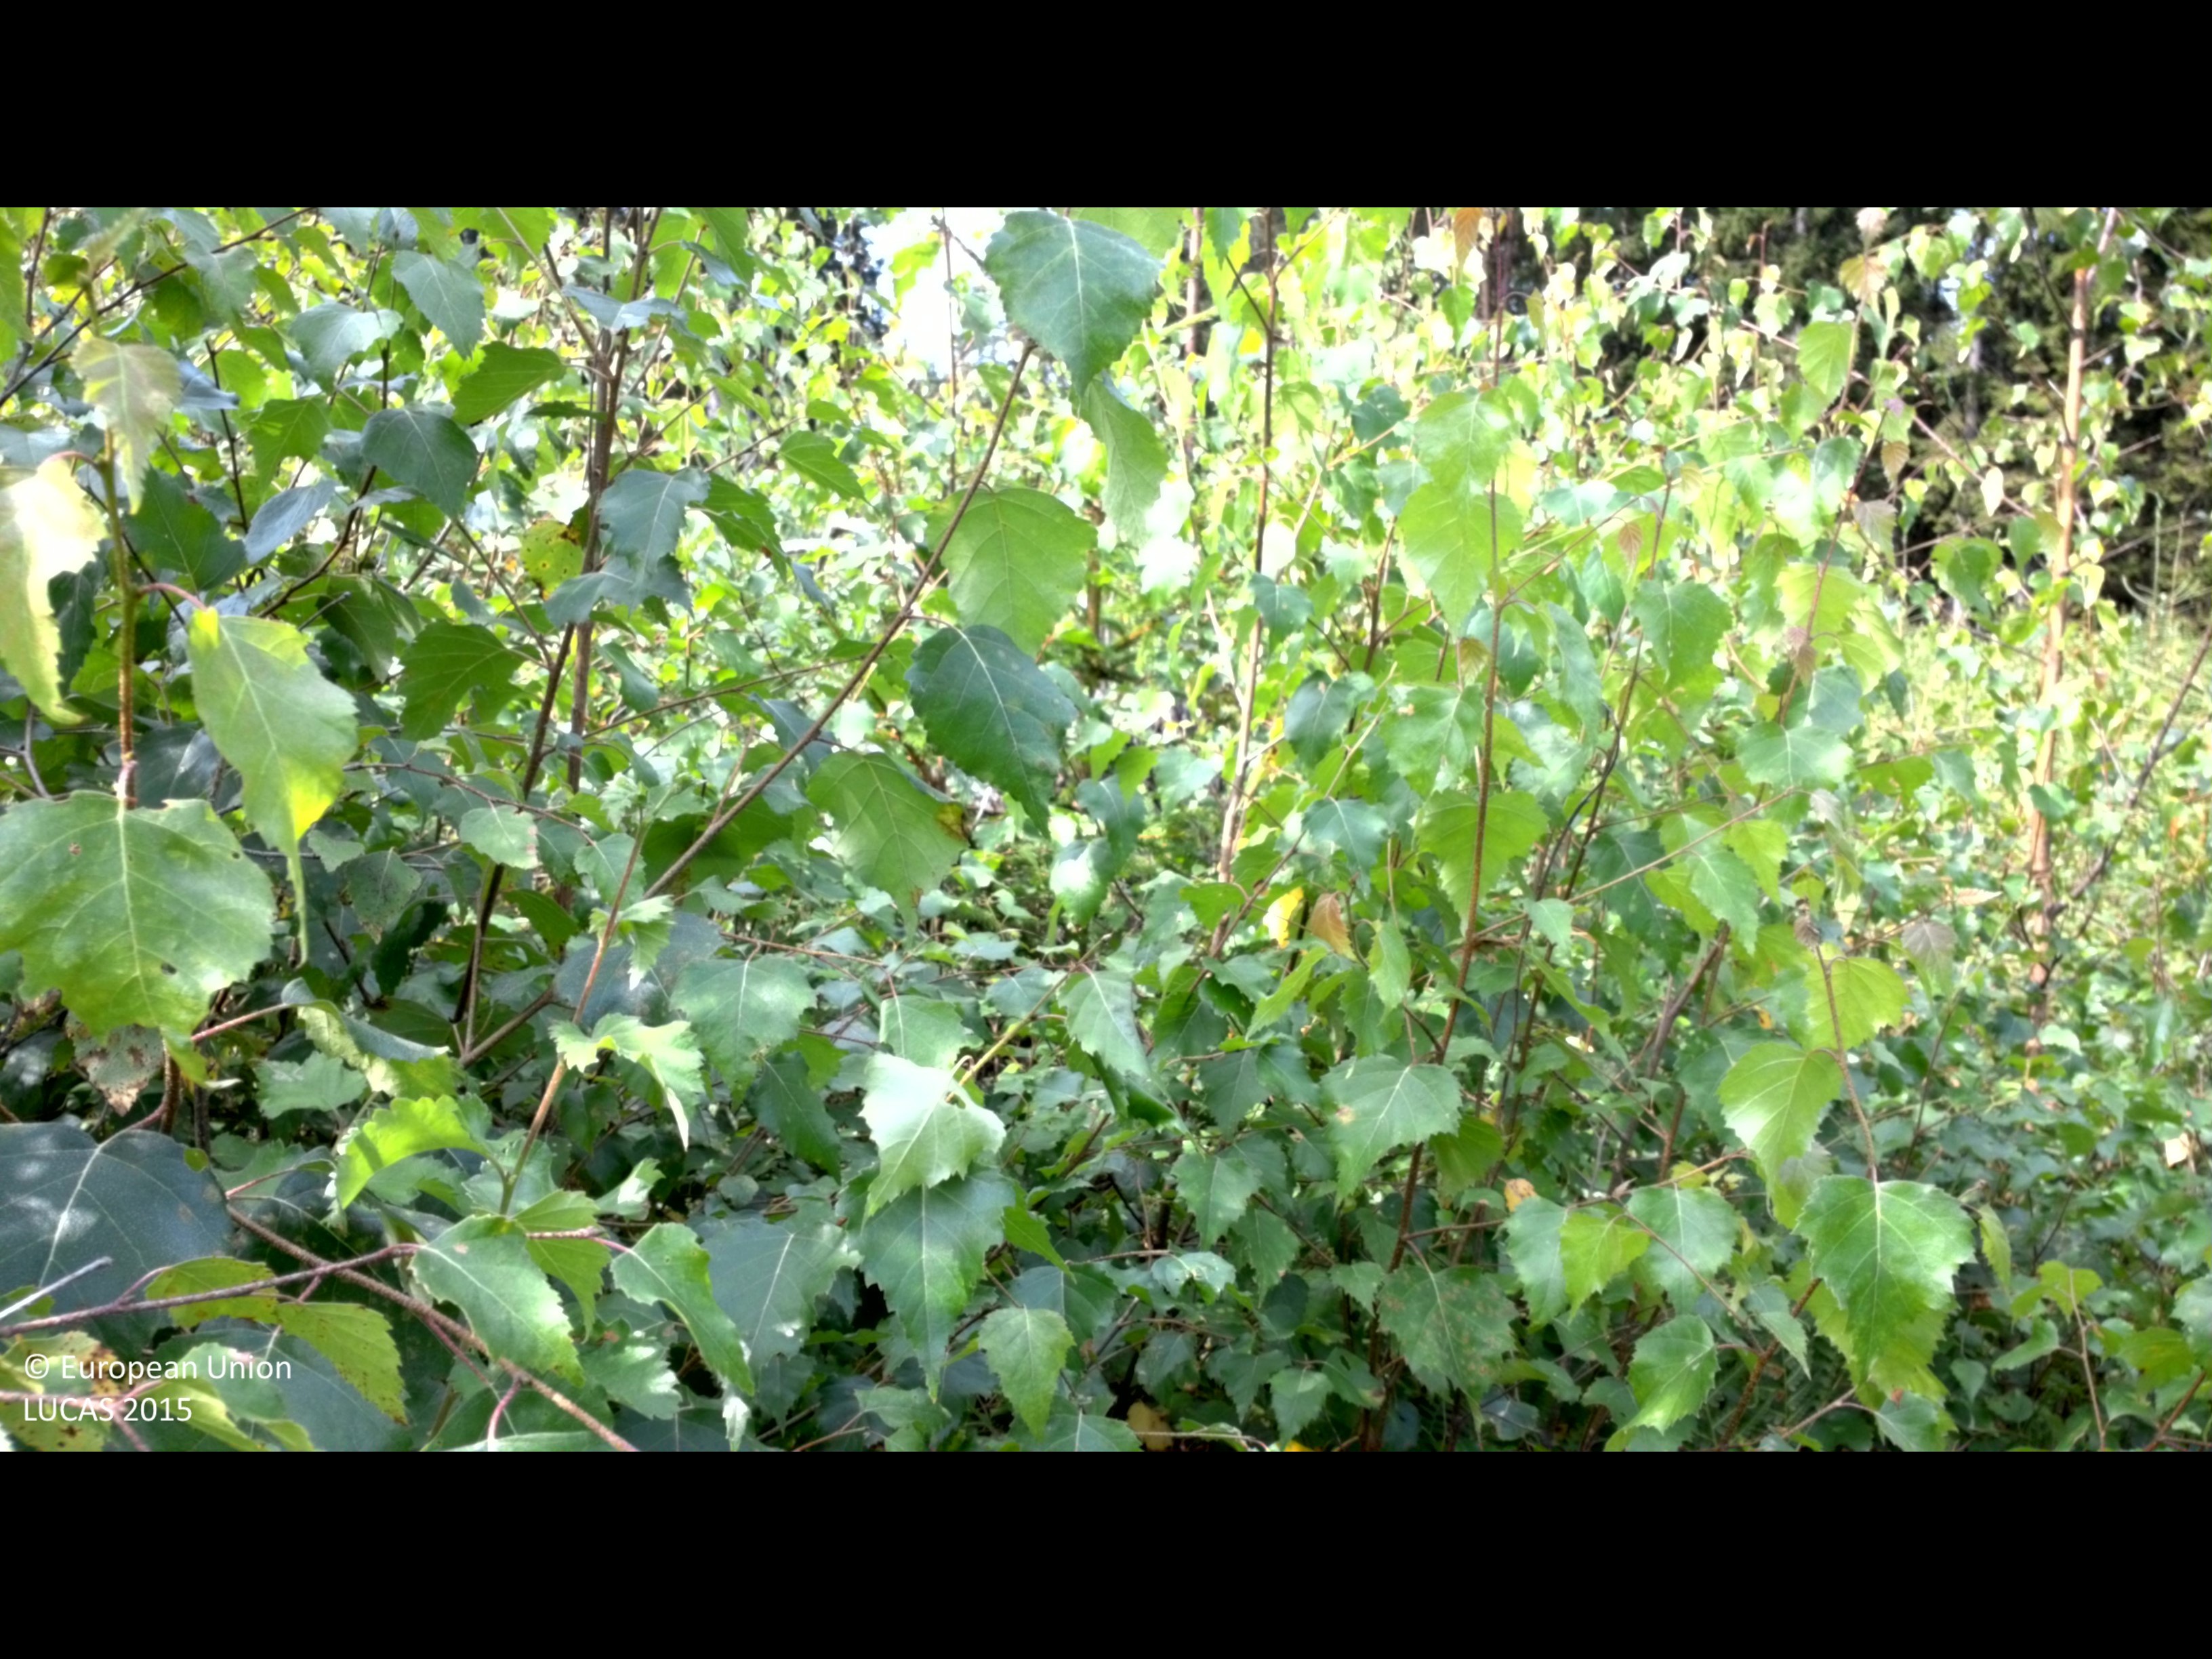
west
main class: Woodland
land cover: Spruce dominated mixed woodland
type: boreal forest
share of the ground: > 75 %
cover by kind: broadleaved forest trees 45 %, coniferous forest trees 30 %, herbaceous plants 20 %, shrubs 5 %
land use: Forestry
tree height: < 5 m
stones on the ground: < 10 %
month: August
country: SE
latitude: 56.8520
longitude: 13.7844
